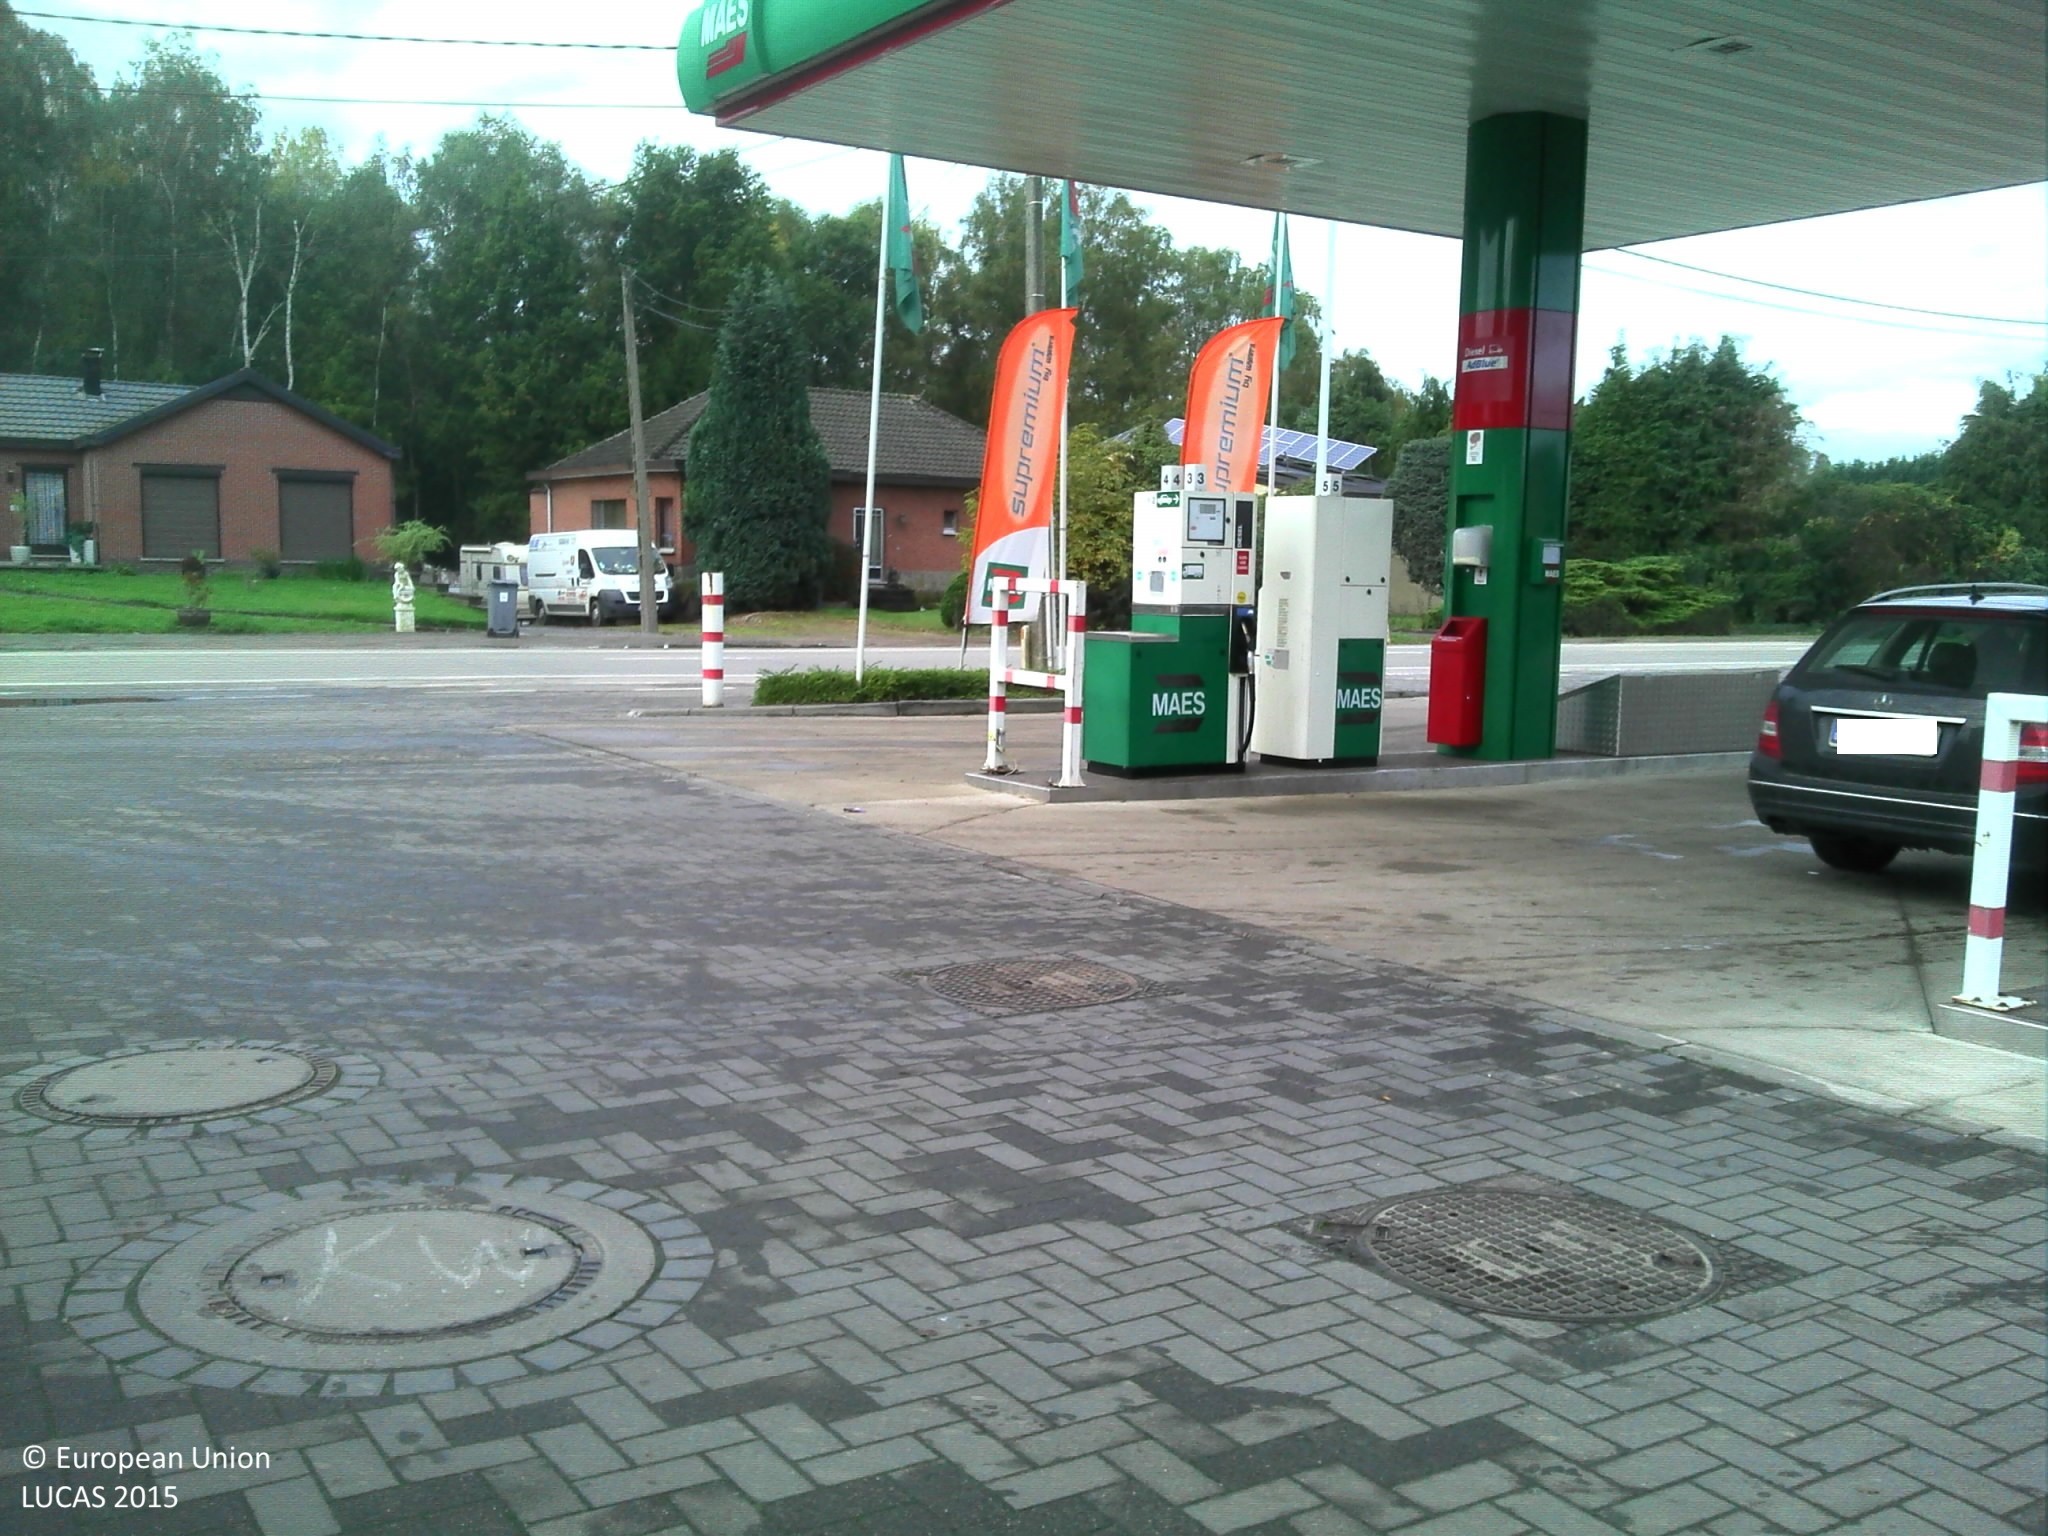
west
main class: Grassland
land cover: Grassland without tree/shrub cover
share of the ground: > 75 %
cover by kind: herbaceous plants 95 %, shrubs 5 %
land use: Residential
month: October
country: BE
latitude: 50.9906
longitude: 4.5393
